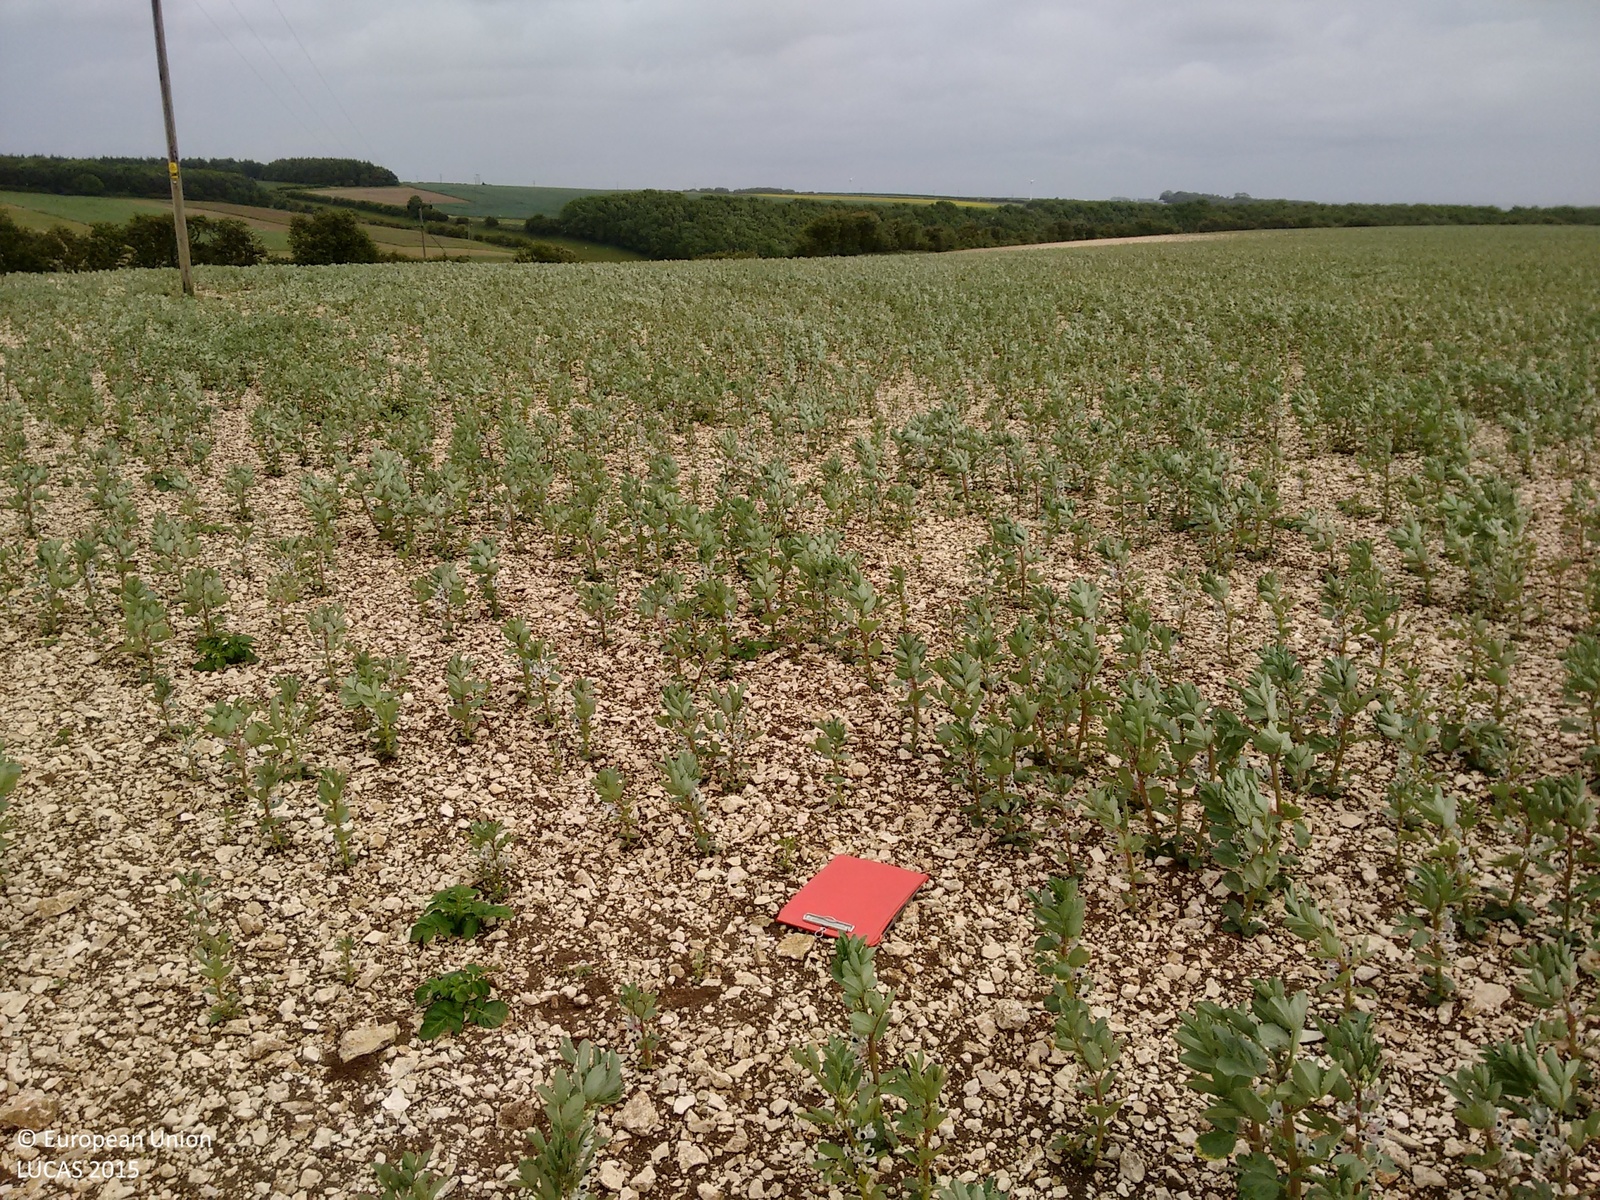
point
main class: Cropland
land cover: Dry pulses
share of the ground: 10 - 25 %
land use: Agriculture (excluding fallow land and kitchen gardens)
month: June
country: GB
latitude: 54.1597
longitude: -0.4959
